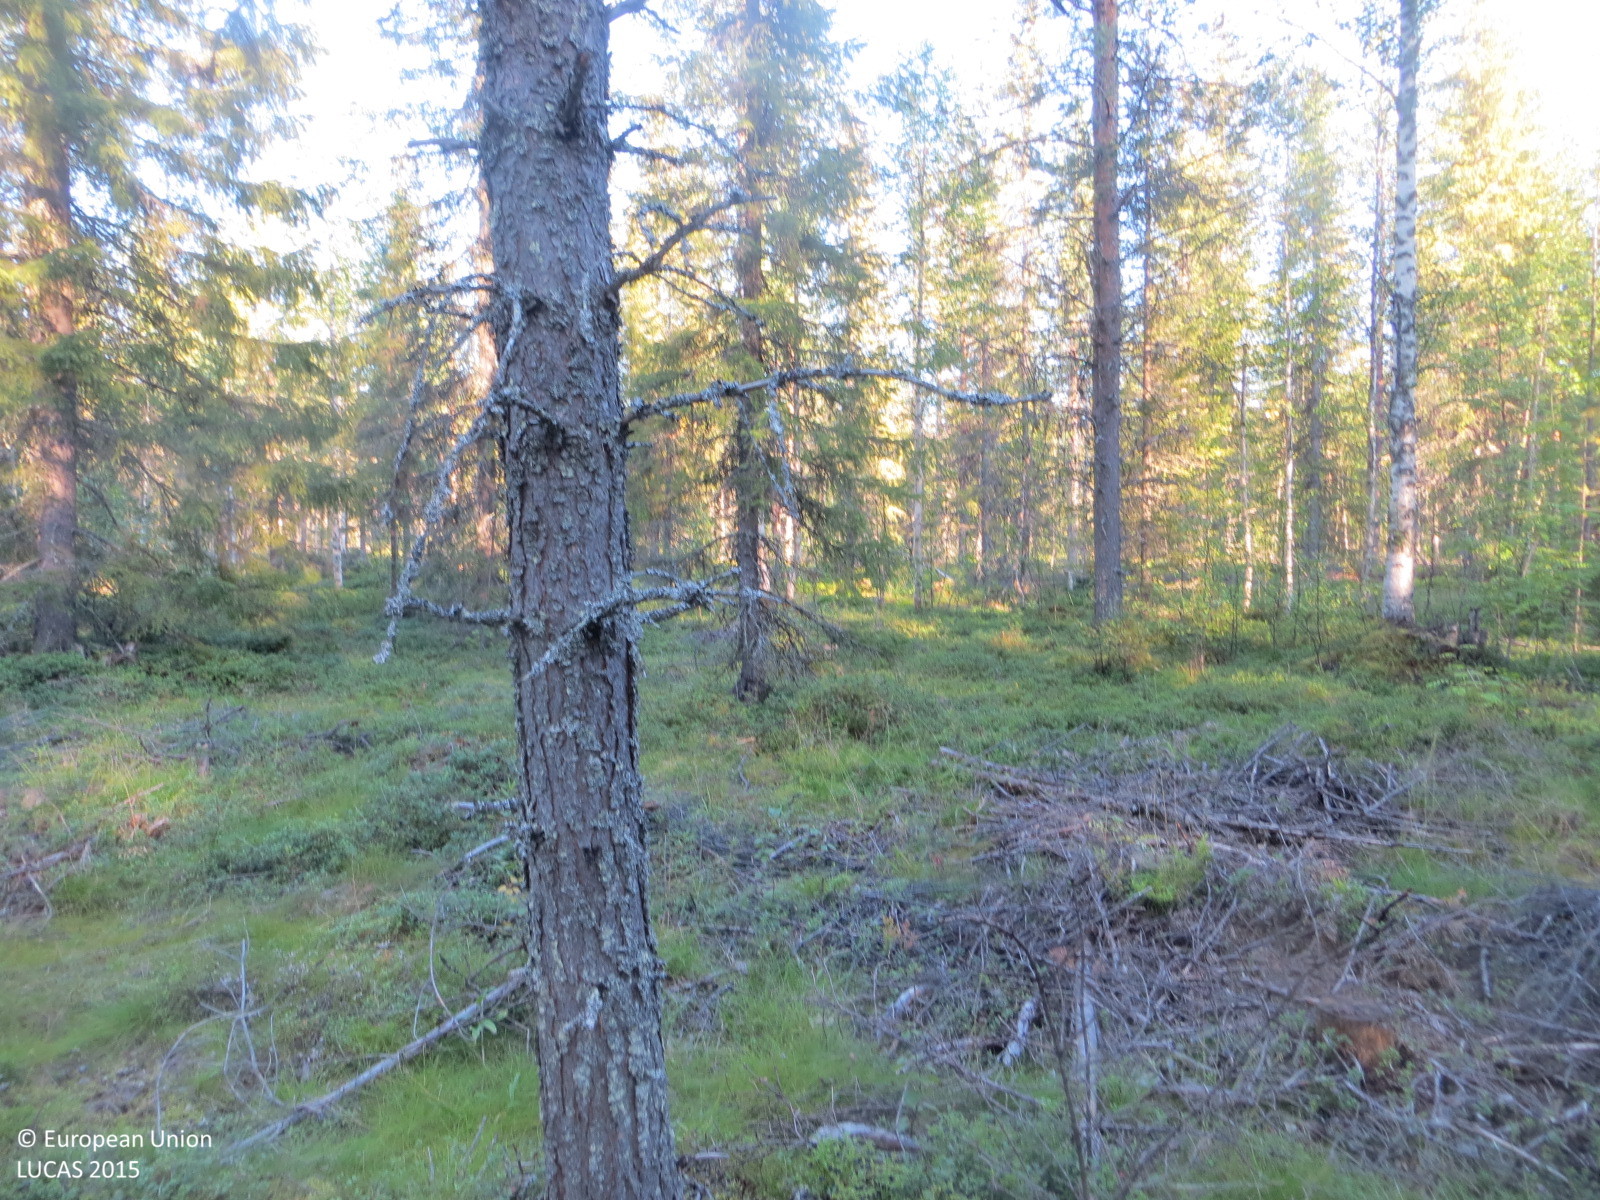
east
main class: Woodland
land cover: Other mixed woodland
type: boreal forest
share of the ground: 50 - 75 %
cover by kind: shrubs 50 %, coniferous forest trees 30 %, broadleaved forest trees 20 %
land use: Forestry
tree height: > 5 m
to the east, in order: Other mixed woodland; Tracks; Other coniferous woodland; Tracks; Other mixed woodland
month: August
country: FI
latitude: 67.2689
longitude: 23.8692
